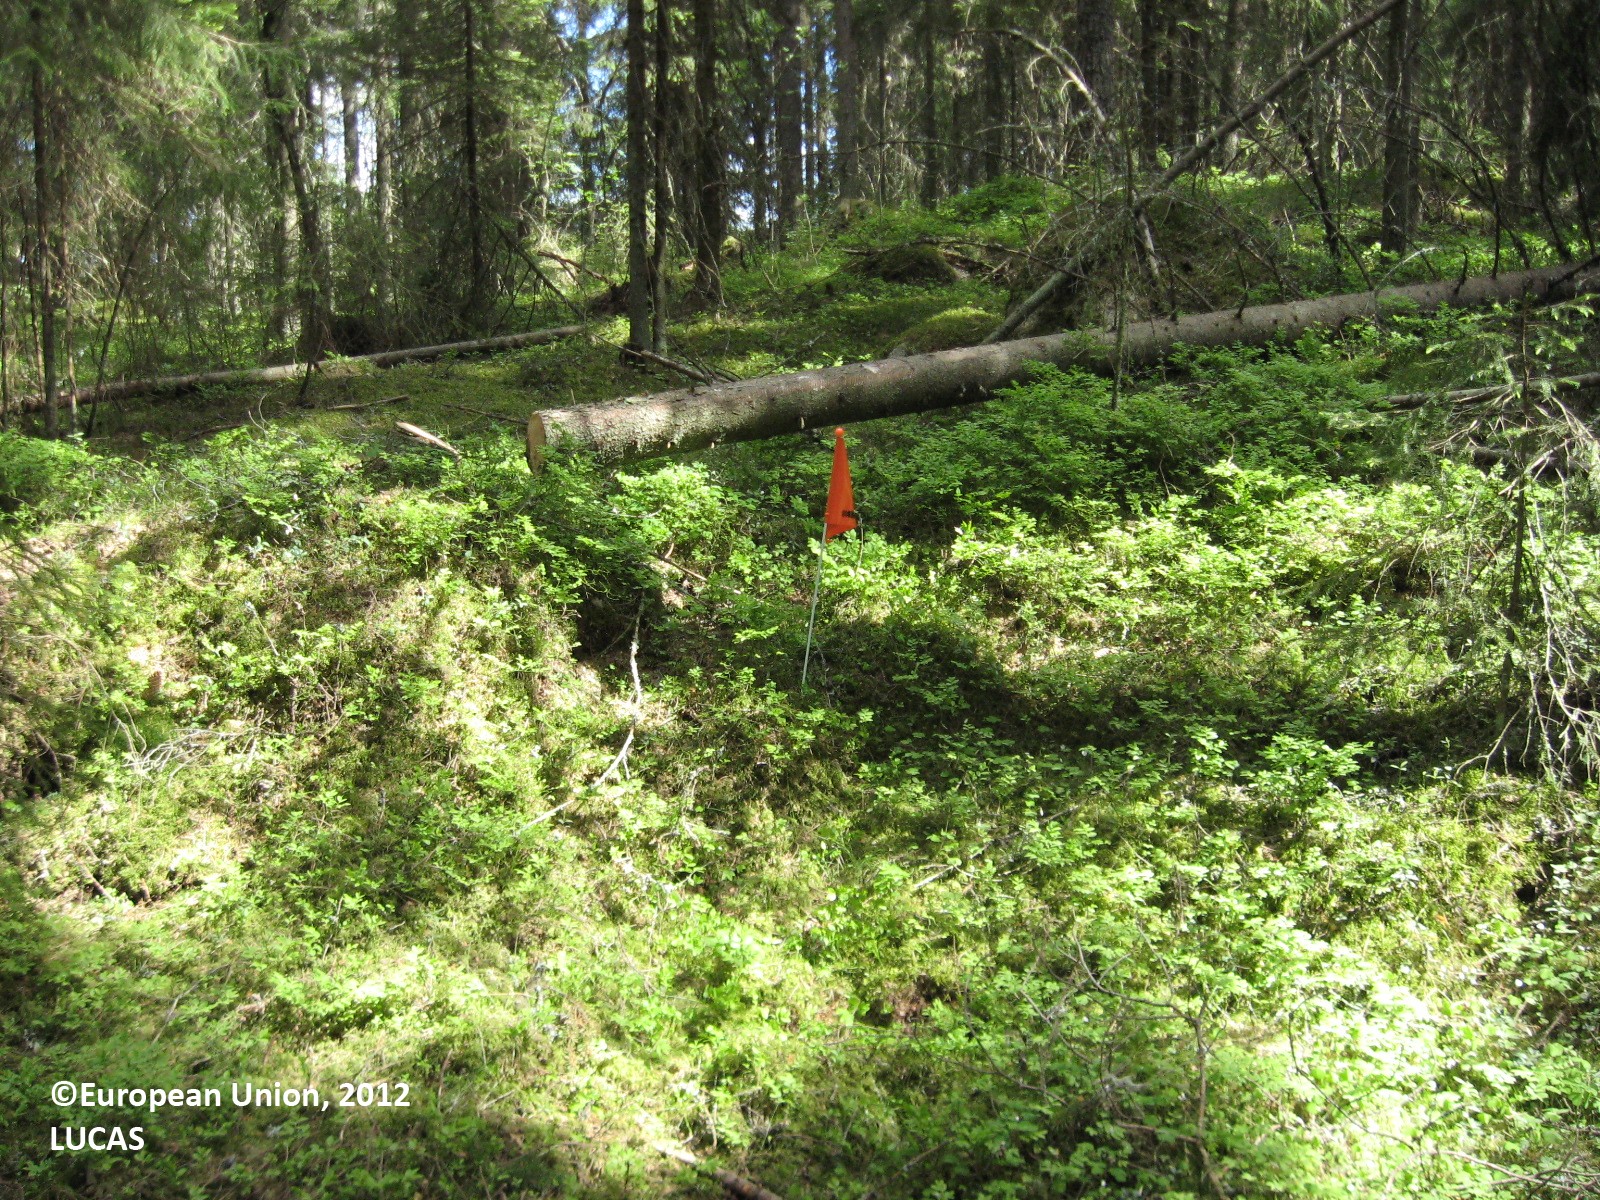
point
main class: Woodland
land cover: Spruce dominated coniferous woodland
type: boreal forest
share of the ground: > 75 %
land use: Forestry
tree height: > 5 m
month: May
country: FI
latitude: 61.7926
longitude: 22.3292
